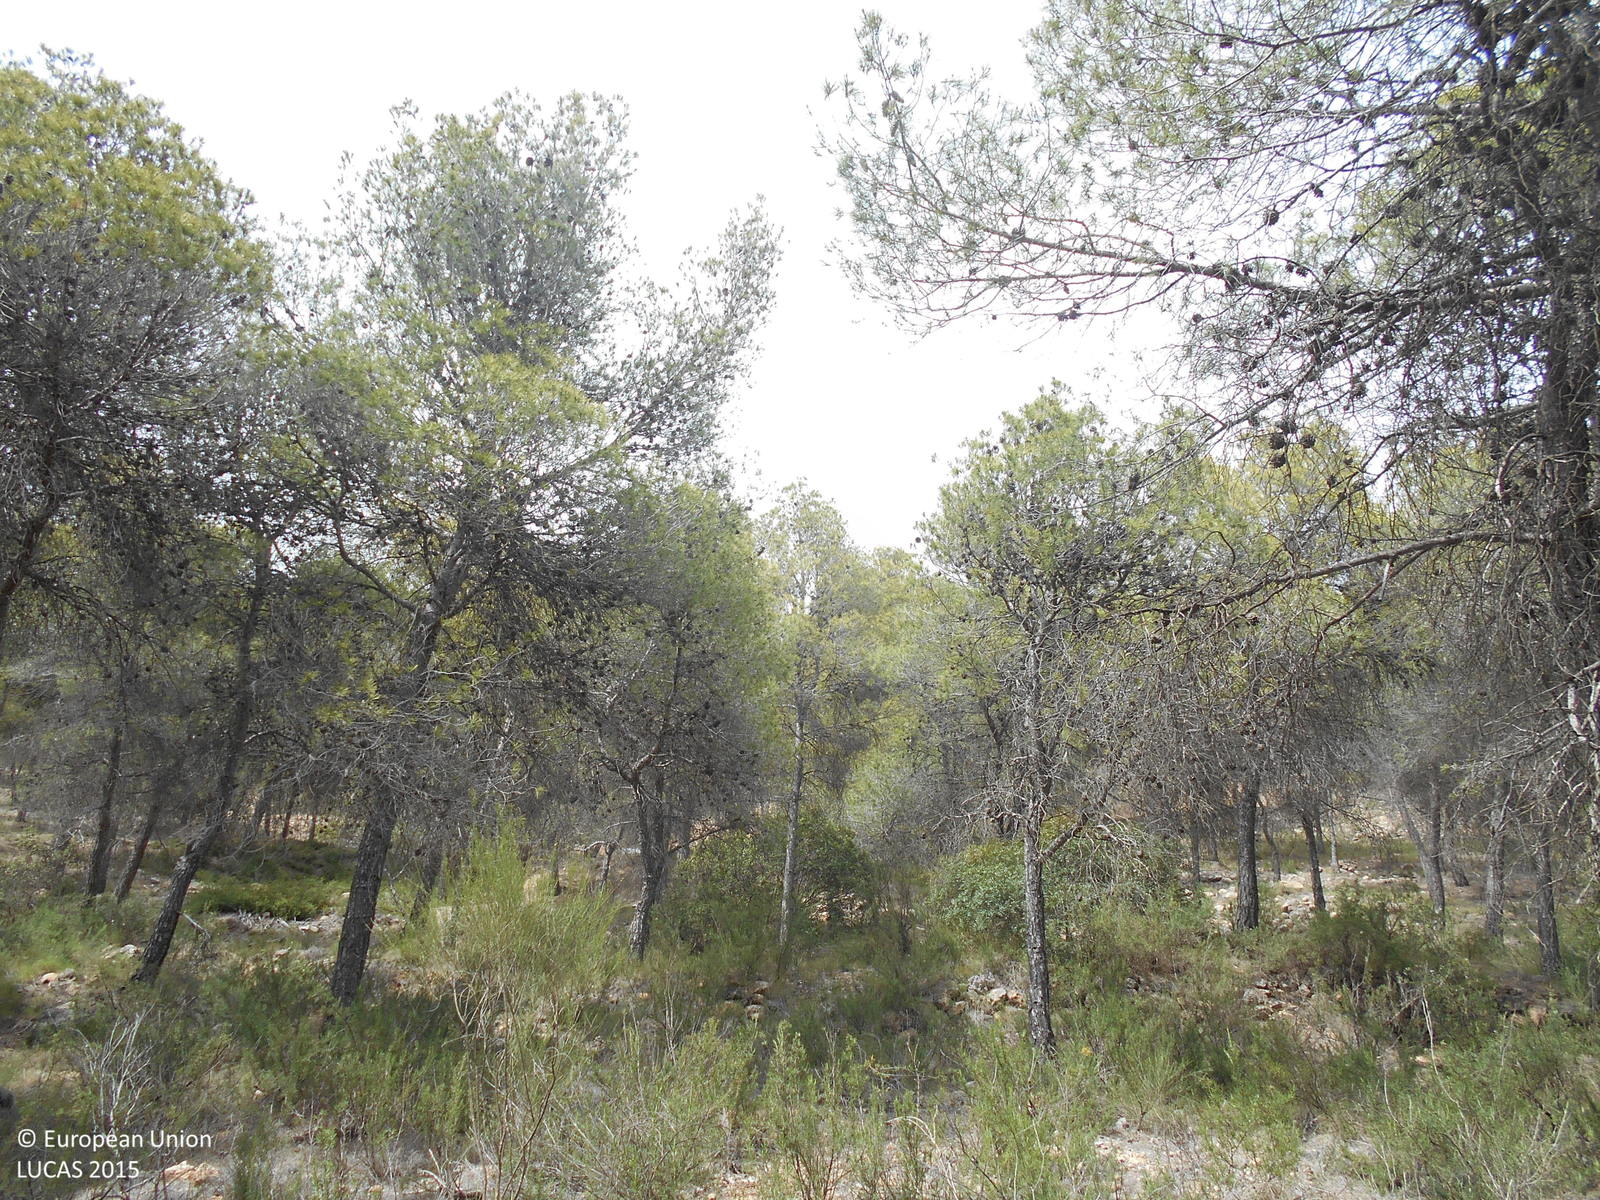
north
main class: Woodland
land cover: Pine dominated coniferous woodland
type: coniferous forest of the mediterranean region
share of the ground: > 75 %
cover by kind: coniferous forest trees 75 %, shrubs 20 %, unconsolidated bare surface 5 %
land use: Semi-natural and natural areas not in use
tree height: > 5 m
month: April
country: ES
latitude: 37.8708
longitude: -1.5000
